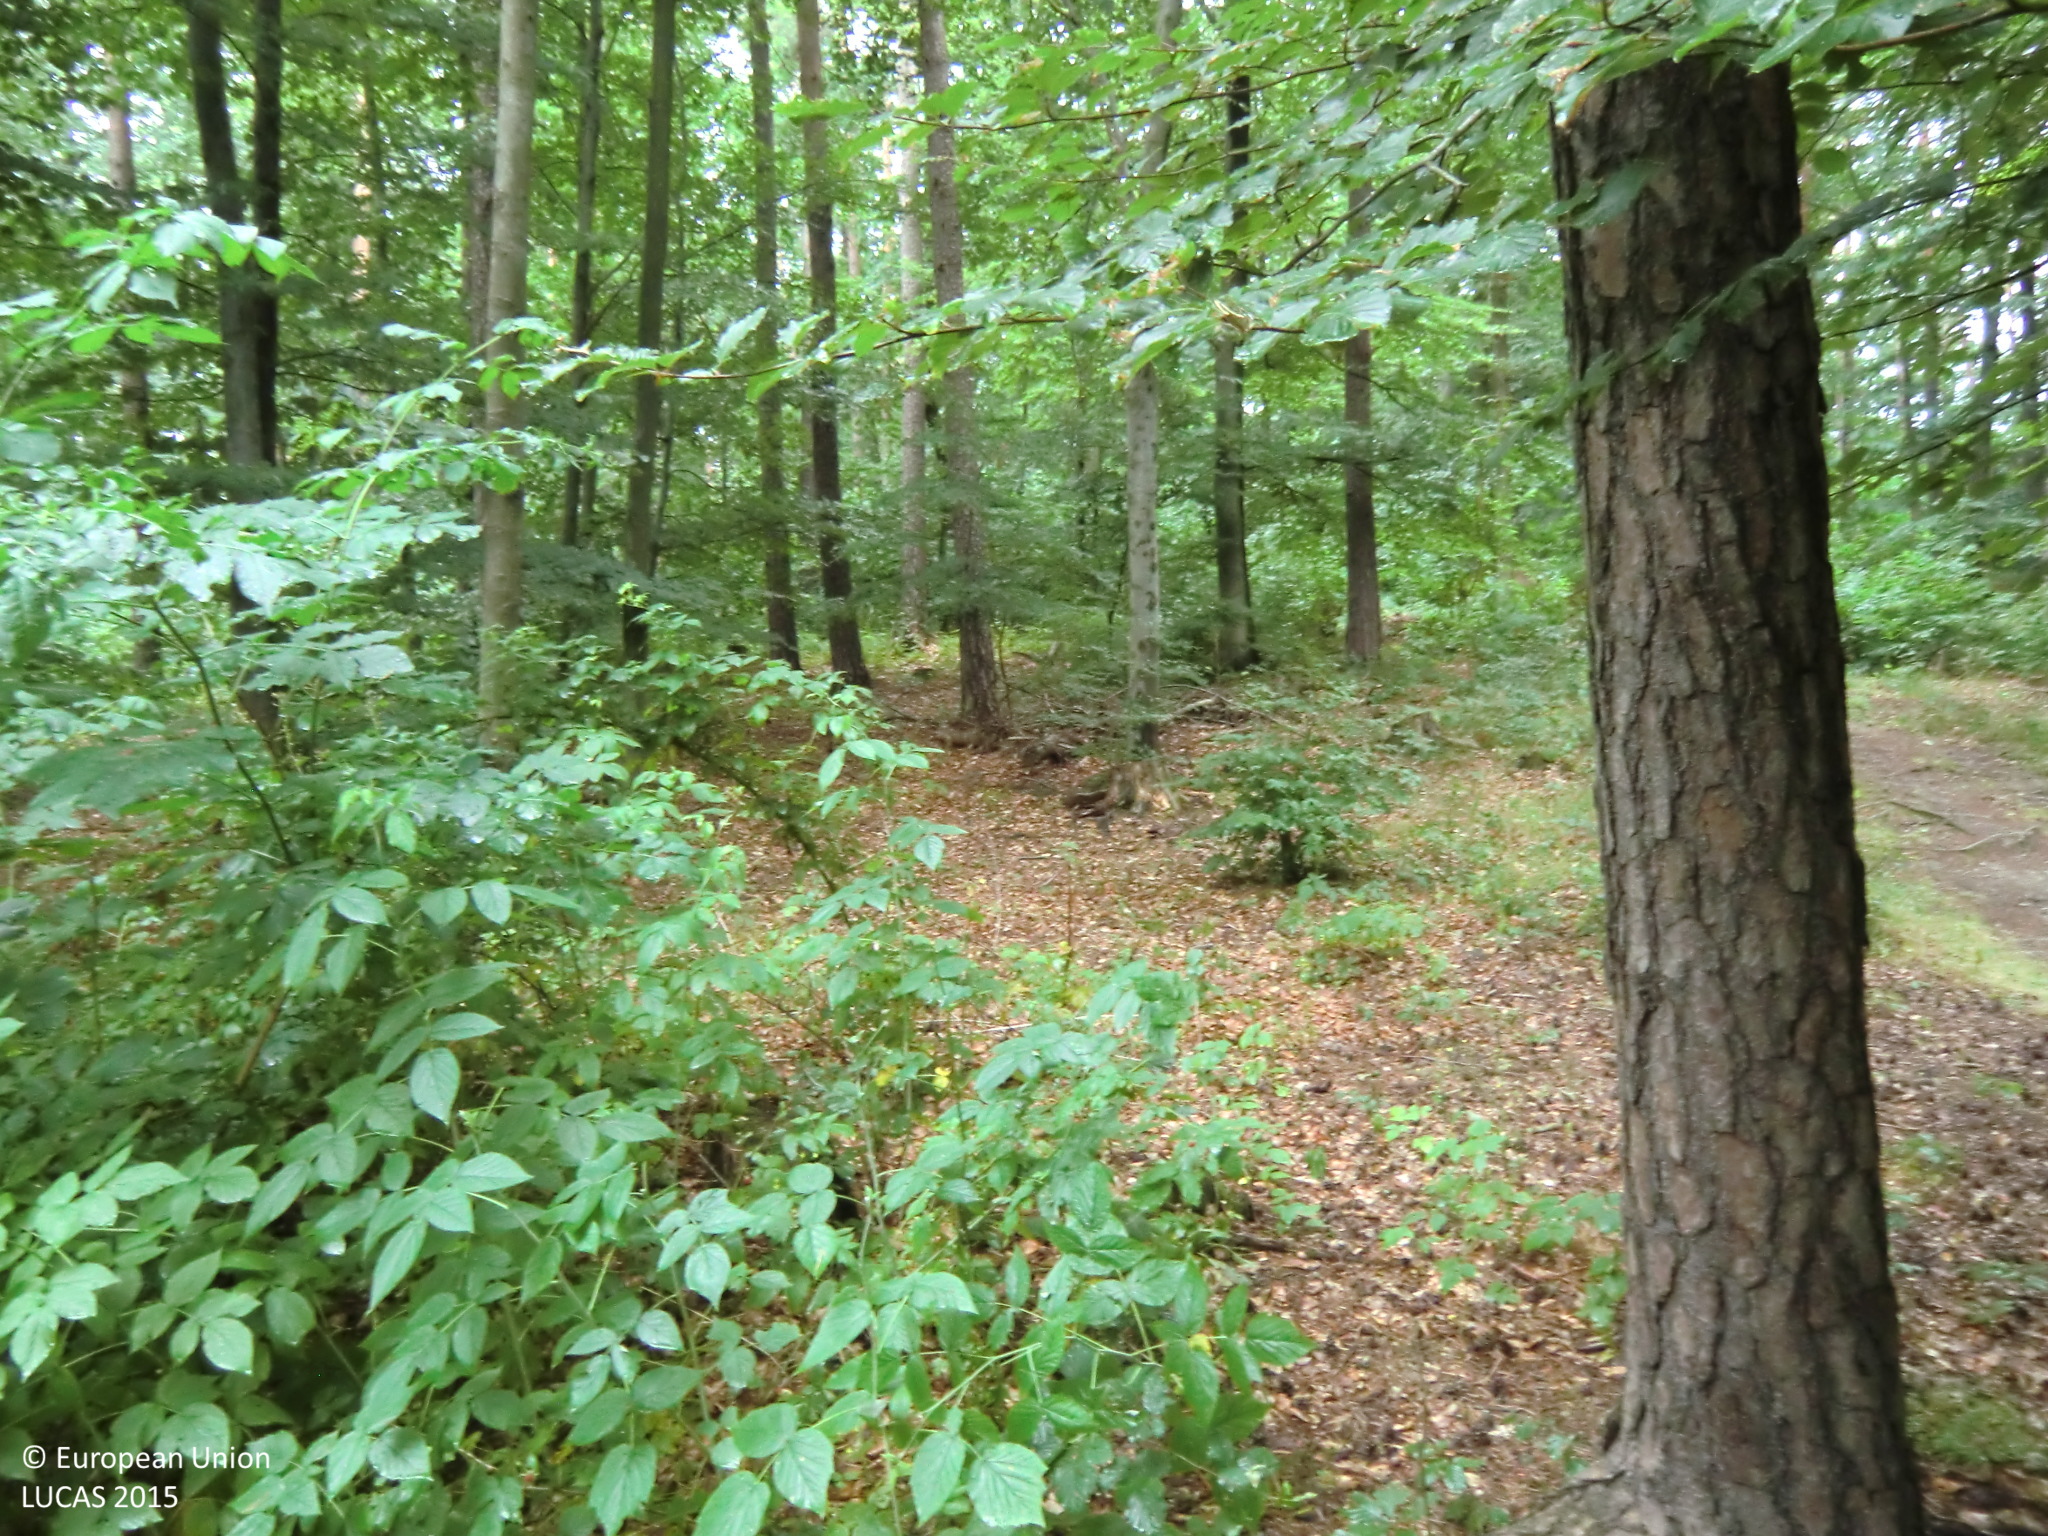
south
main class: Woodland
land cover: Pine dominated mixed woodland
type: hemiboreal forest and nemoral coniferous forest and mixed broadleaved-coniferous forest
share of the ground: 50 - 75 %
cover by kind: broadleaved forest trees 40 %, coniferous forest trees 30 %, shrubs 20 %, unconsolidated bare surface 10 %
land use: Forestry
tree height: > 5 m
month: July
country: AT
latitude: 47.1137
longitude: 15.4693
